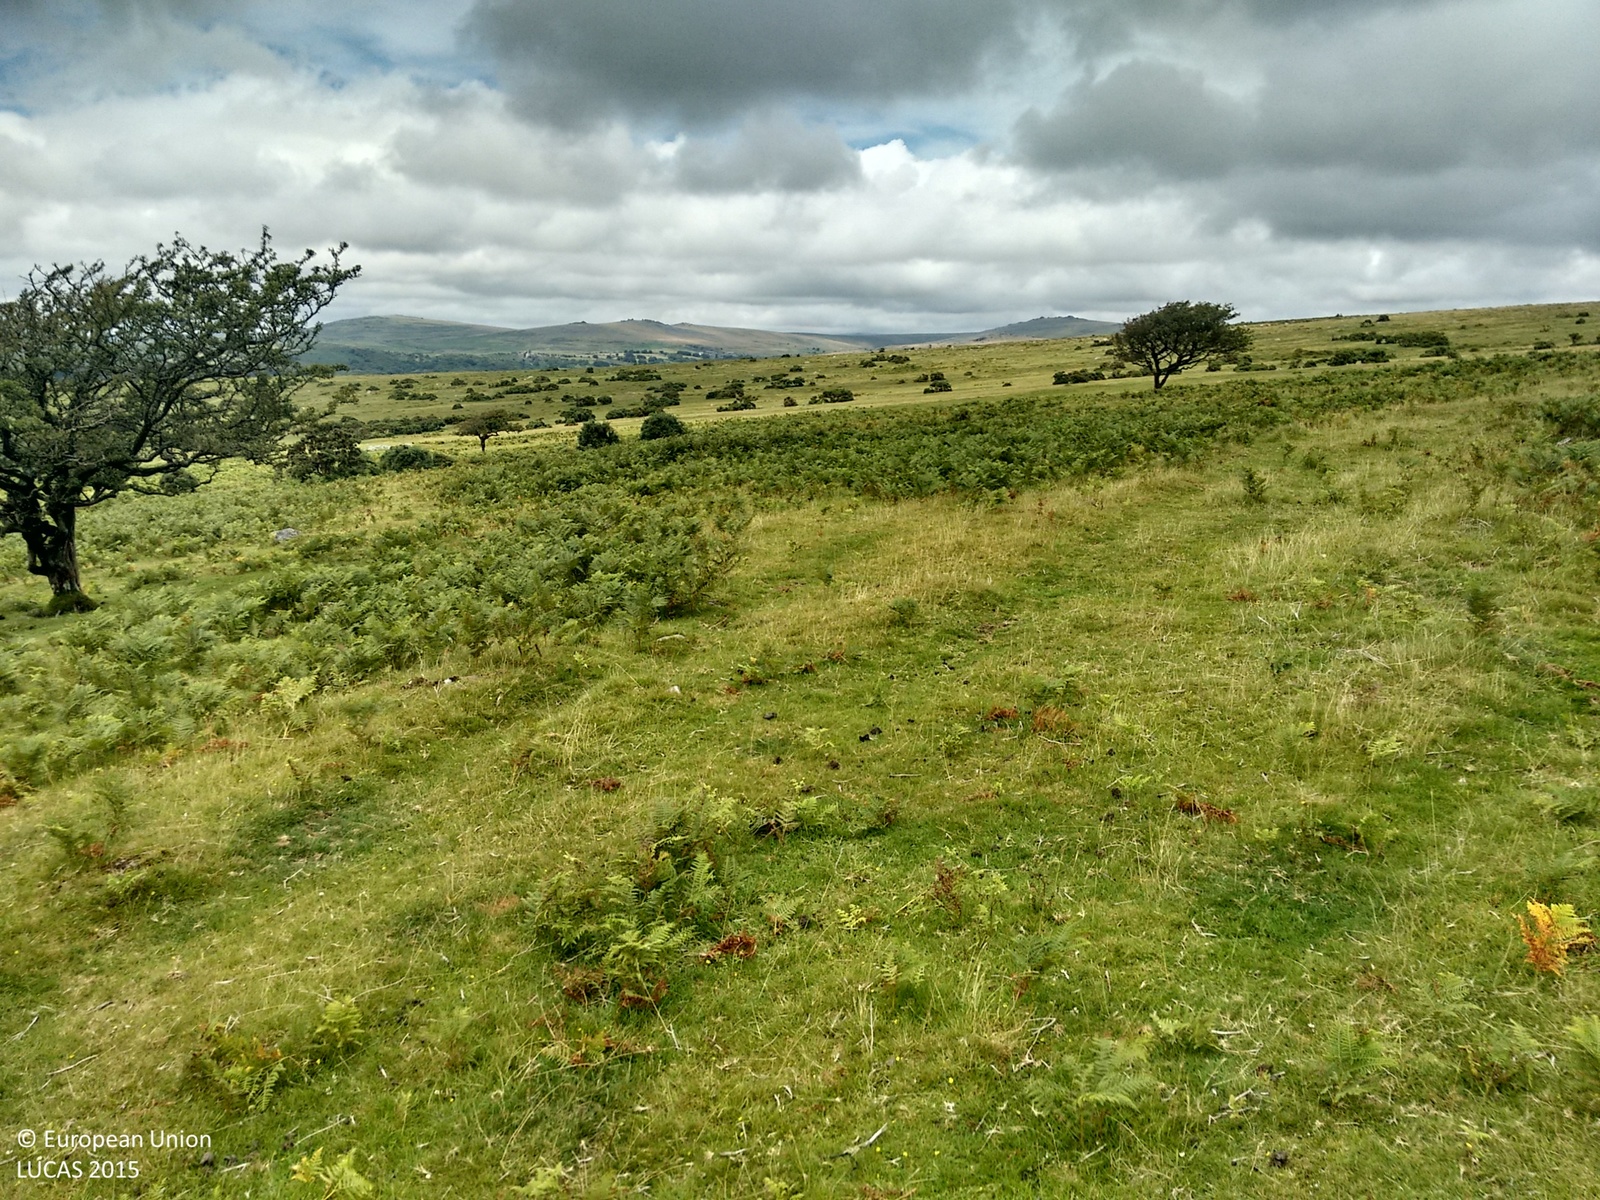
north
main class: Grassland
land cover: Grassland without tree/shrub cover
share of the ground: > 75 %
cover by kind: herbaceous plants 100 %
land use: Agriculture (excluding fallow land and kitchen gardens)
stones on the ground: < 10 %
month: August
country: GB
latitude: 50.5146
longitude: -4.0421
